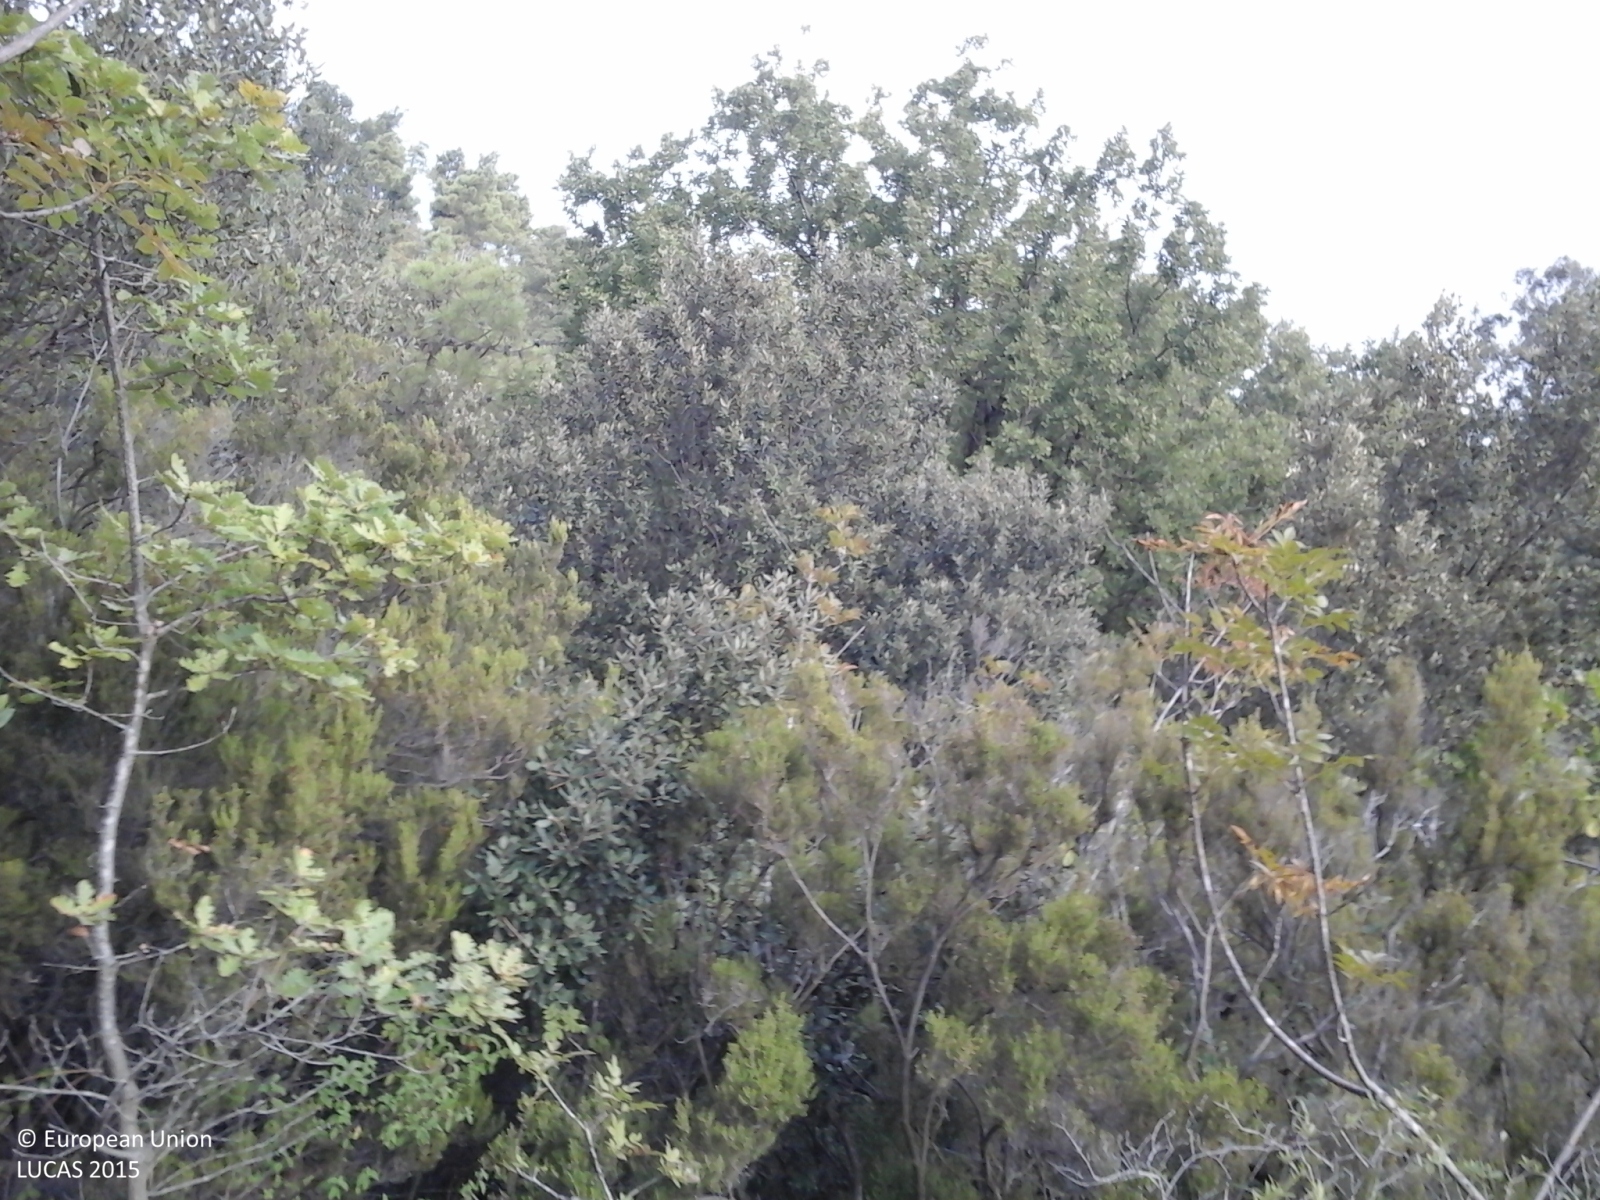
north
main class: Woodland
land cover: Pine dominated mixed woodland
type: coniferous forest of the mediterranean region
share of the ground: > 75 %
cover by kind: coniferous forest trees 50 %, broadleaved forest trees 30 %, shrubs 20 %
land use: Semi-natural and natural areas not in use
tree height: > 5 m
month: September
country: IT
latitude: 44.2106
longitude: 8.3143
